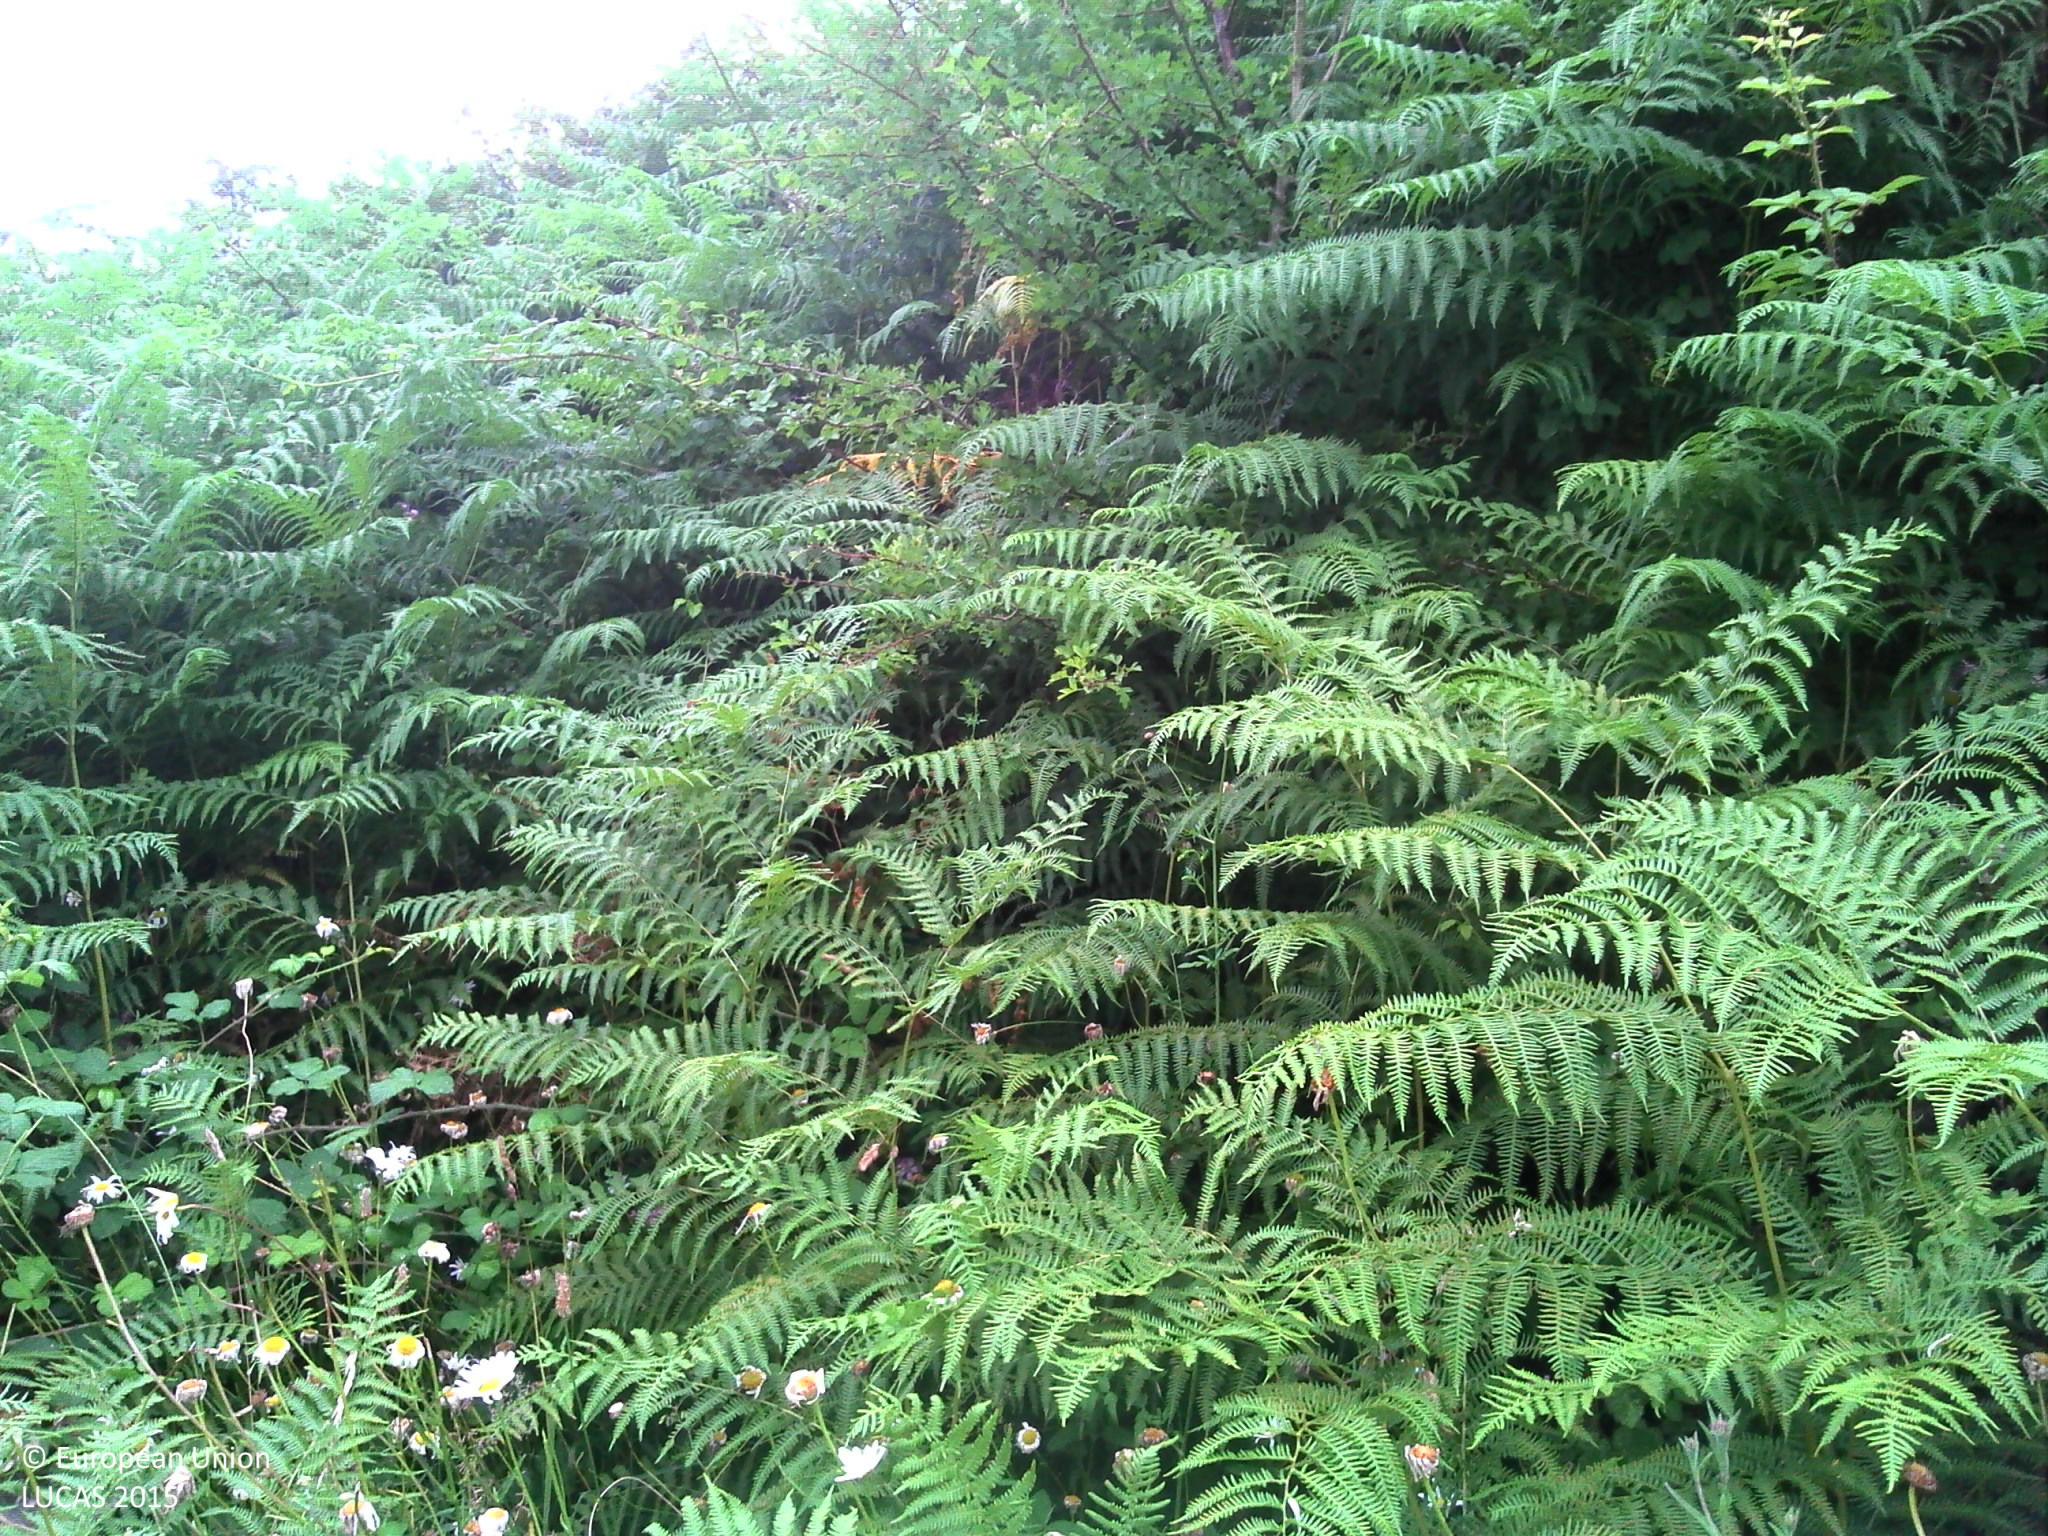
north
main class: Grassland
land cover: Spontaneously vegetated surfaces
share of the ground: > 75 %
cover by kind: herbaceous plants 95 %, shrubs 5 %
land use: Agriculture (excluding fallow land and kitchen gardens)
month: July
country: FR
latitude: 48.9701
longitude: 0.0660
